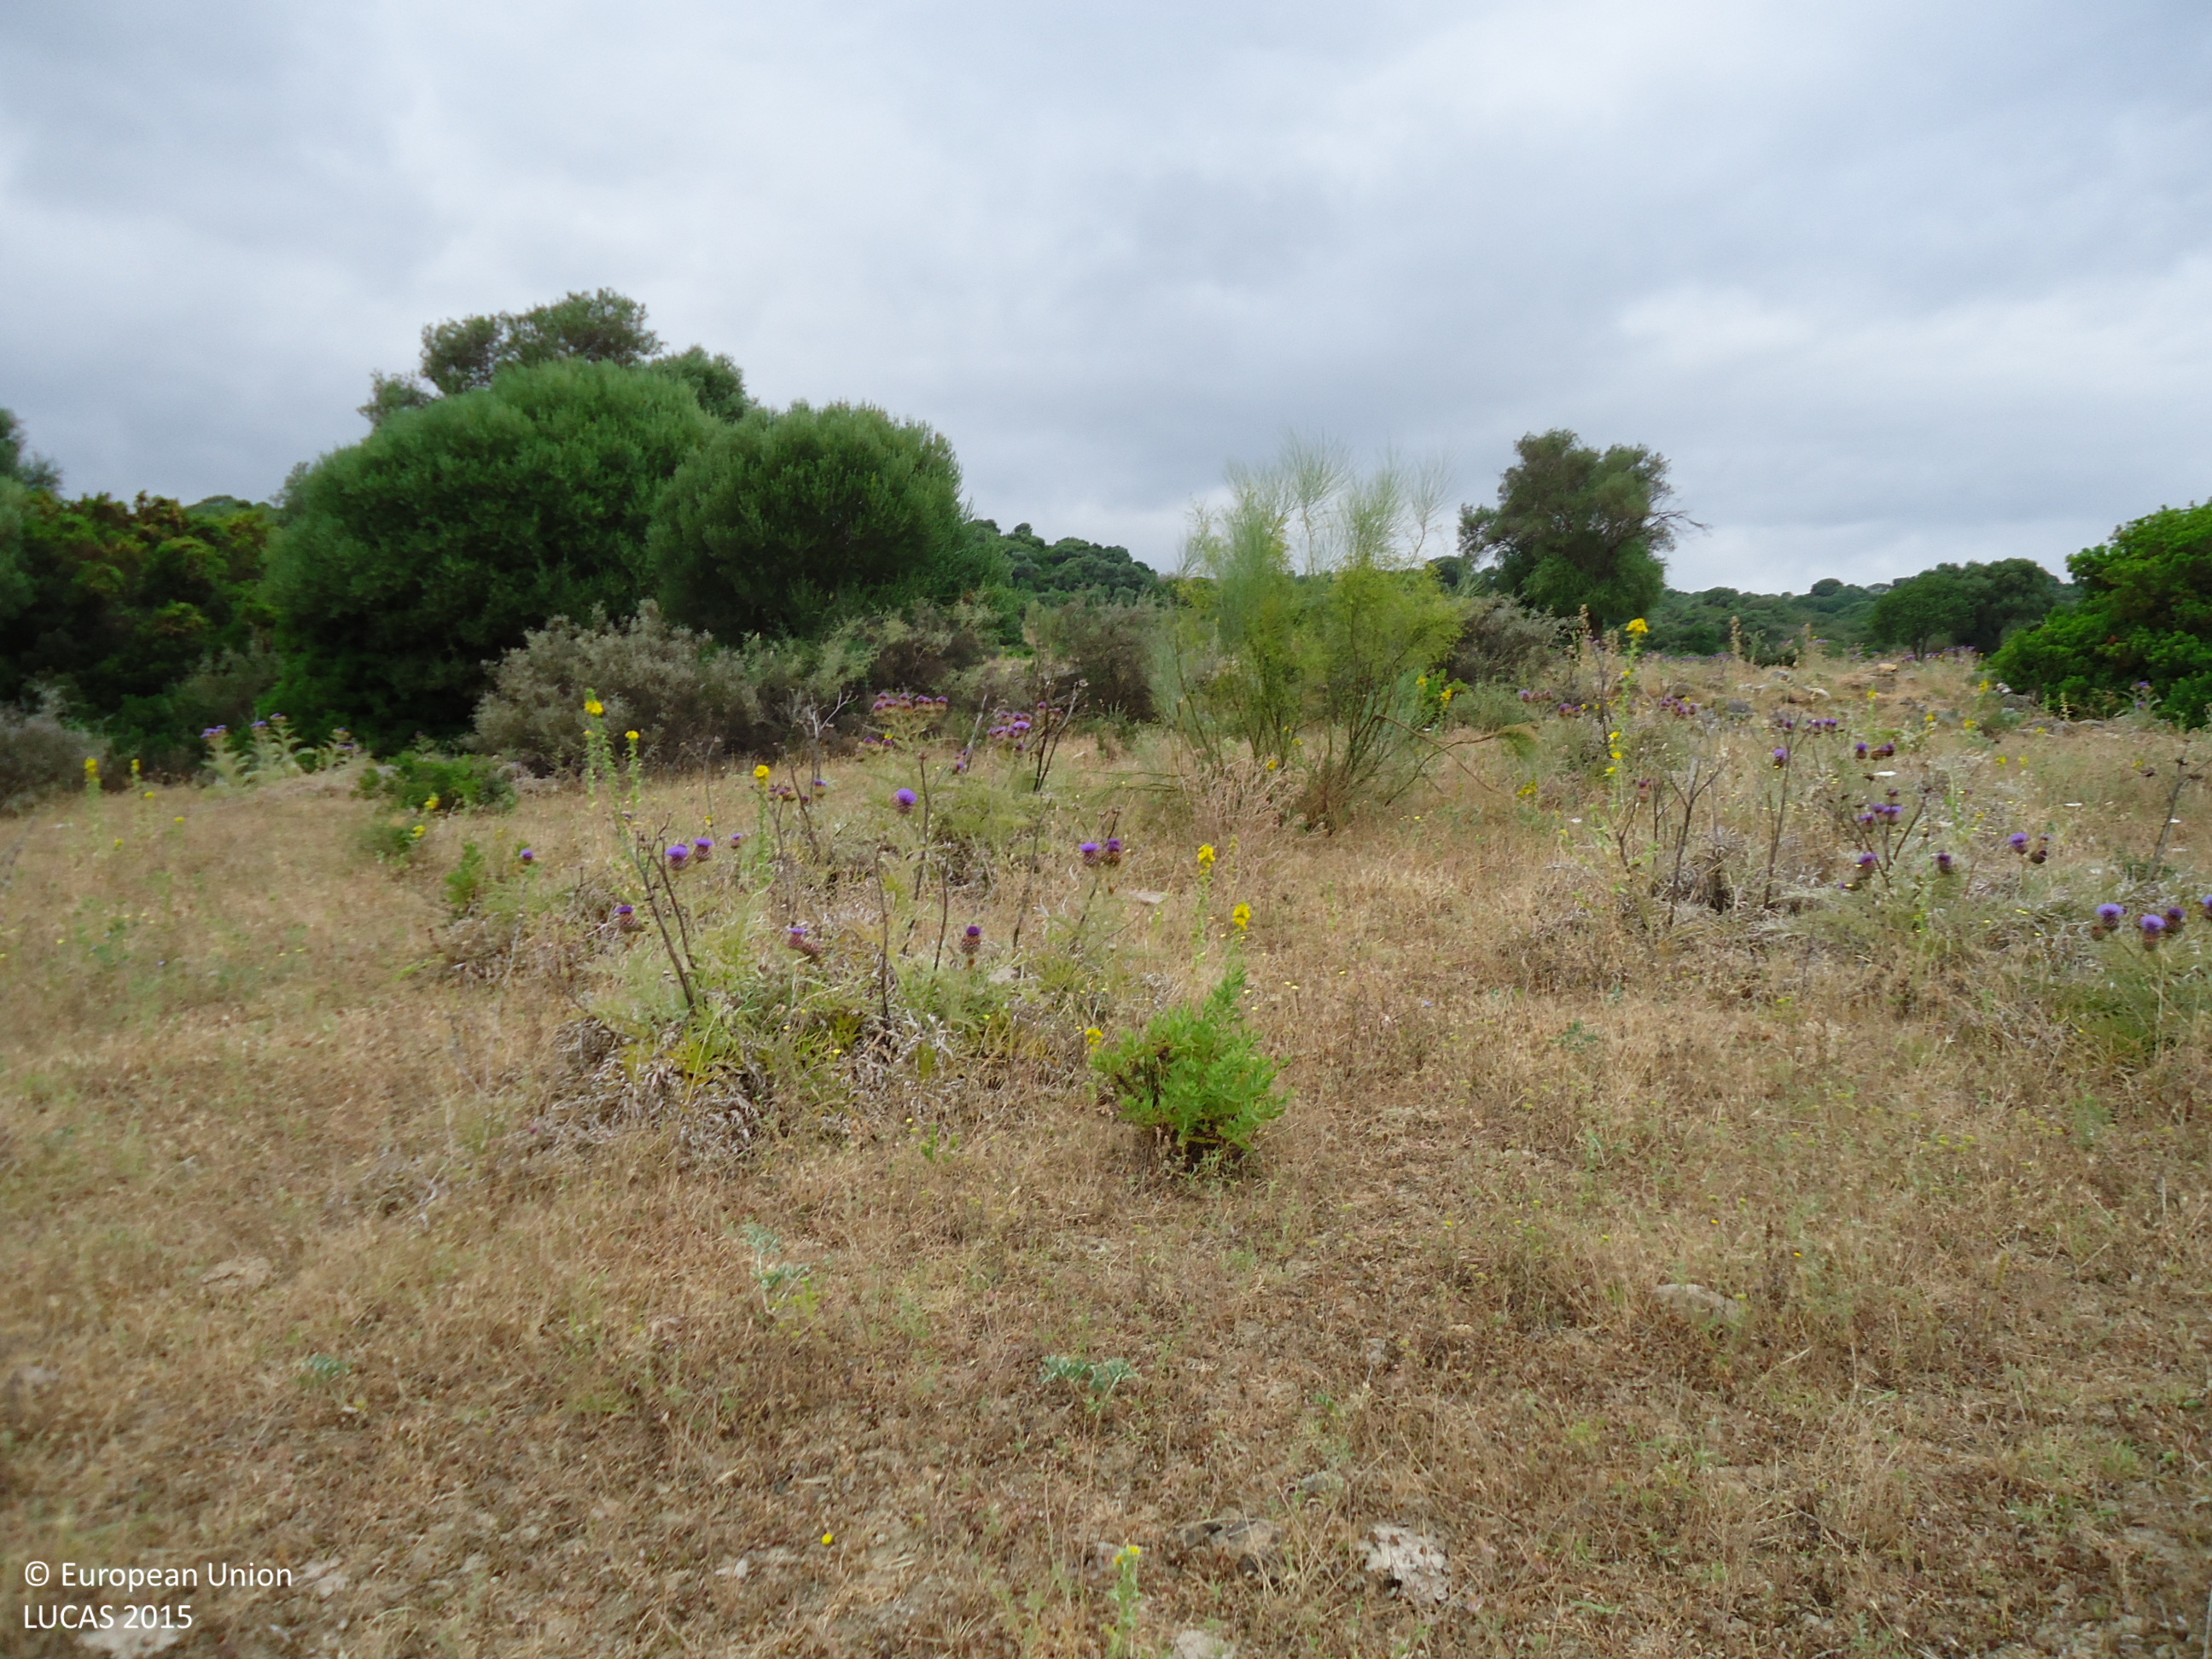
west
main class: Grassland
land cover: Grassland without tree/shrub cover
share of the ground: > 75 %
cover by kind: herbaceous plants 100 %
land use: Agriculture (excluding fallow land and kitchen gardens)
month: June
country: ES
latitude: 36.4582
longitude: -5.3388
